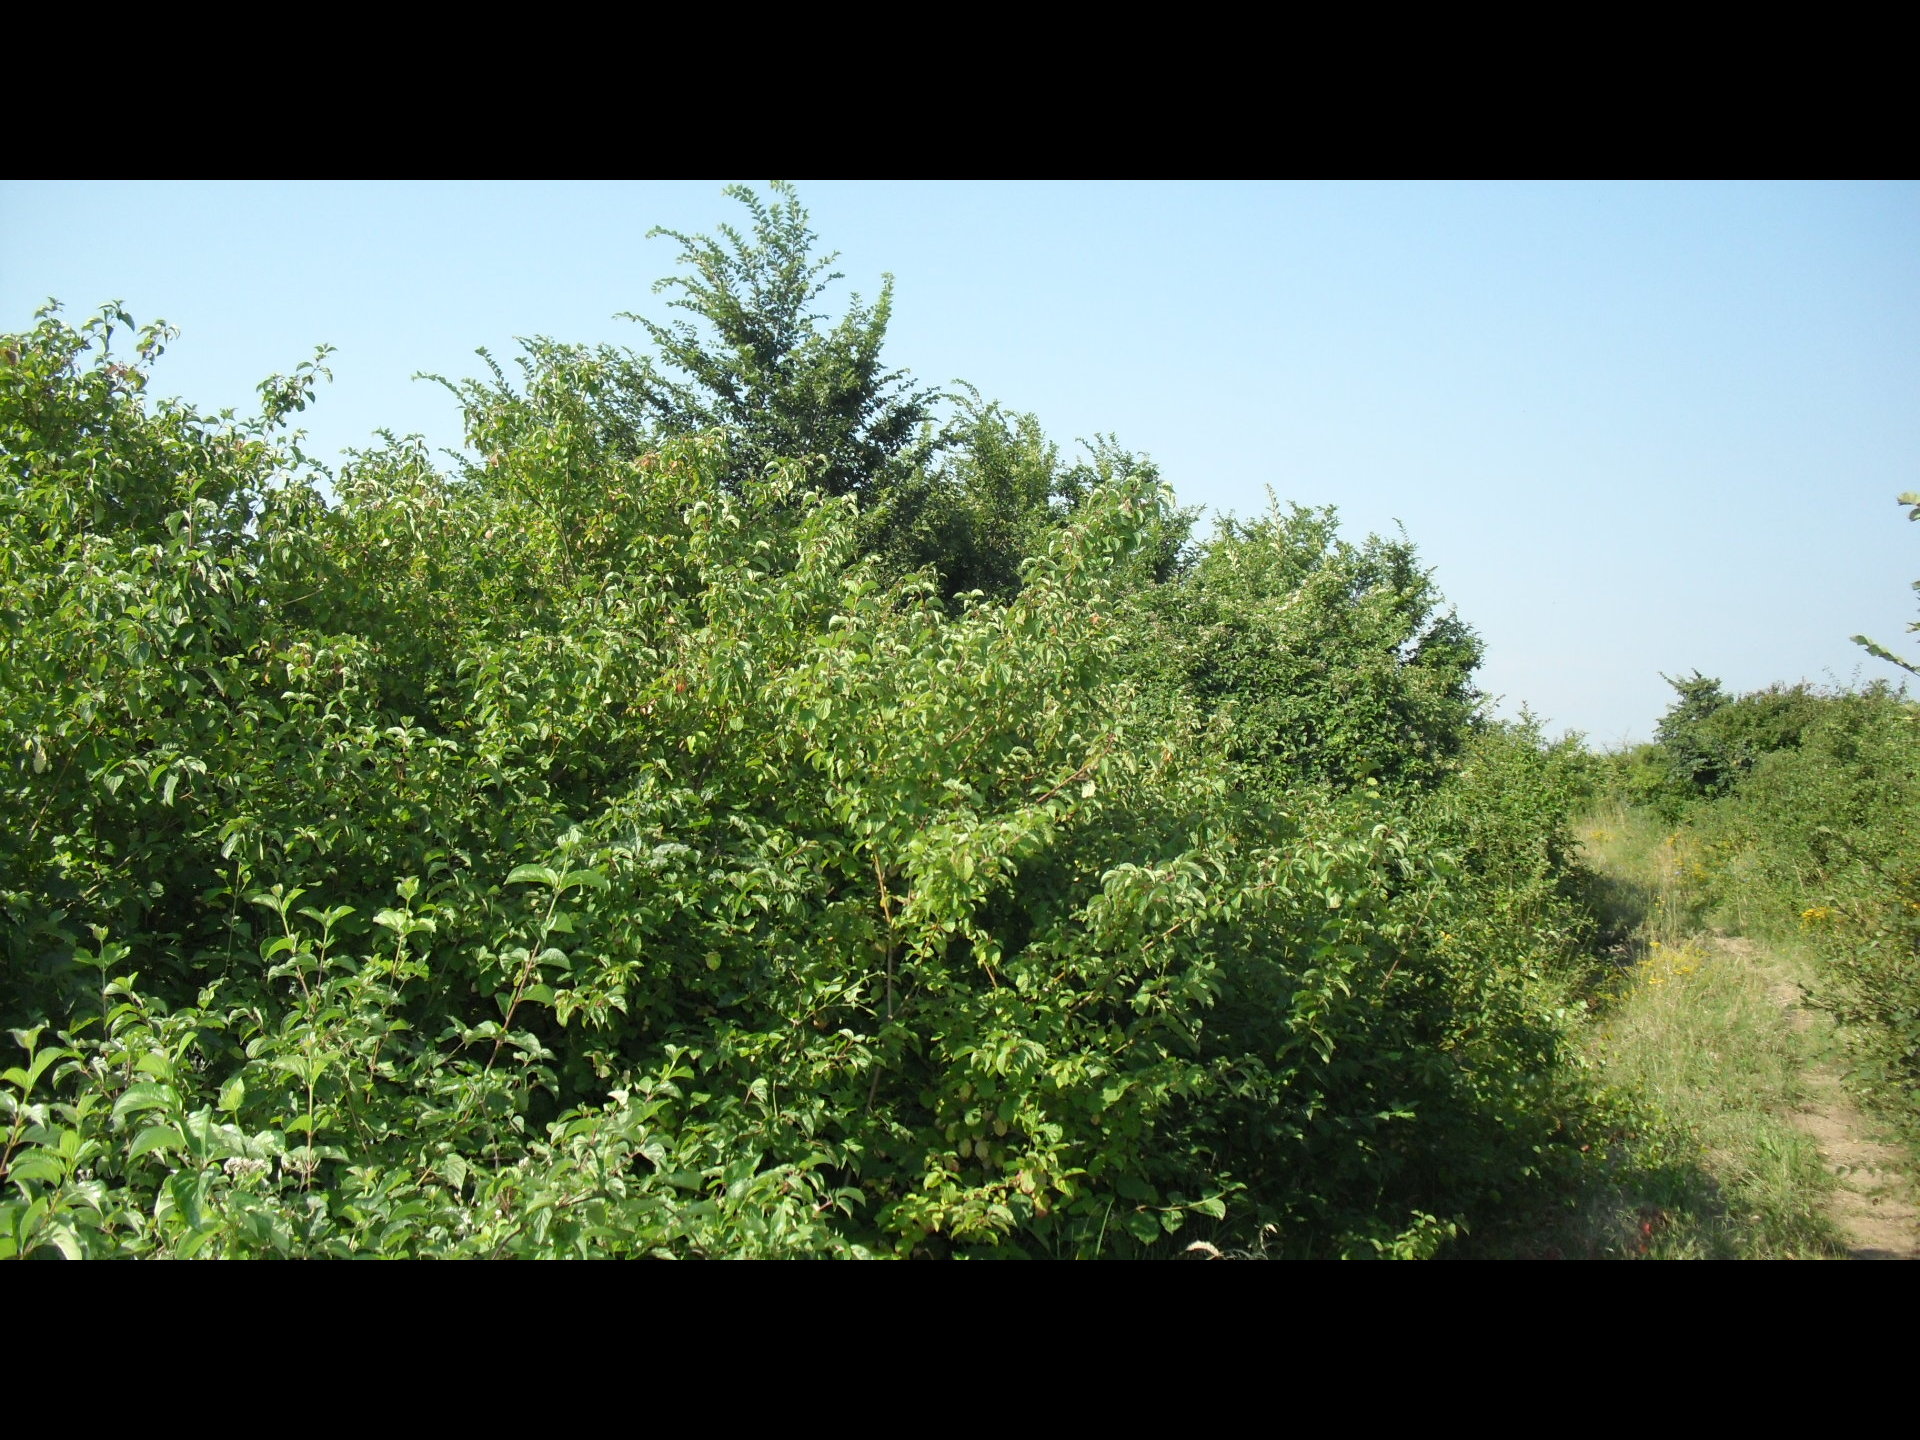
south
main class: Shrubland
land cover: Shrubland without tree cover
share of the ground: > 75 %
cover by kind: shrubs 85 %, herbaceous plants 15 %
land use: Semi-natural and natural areas not in use
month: July
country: BG
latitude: 43.7875
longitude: 22.9754
